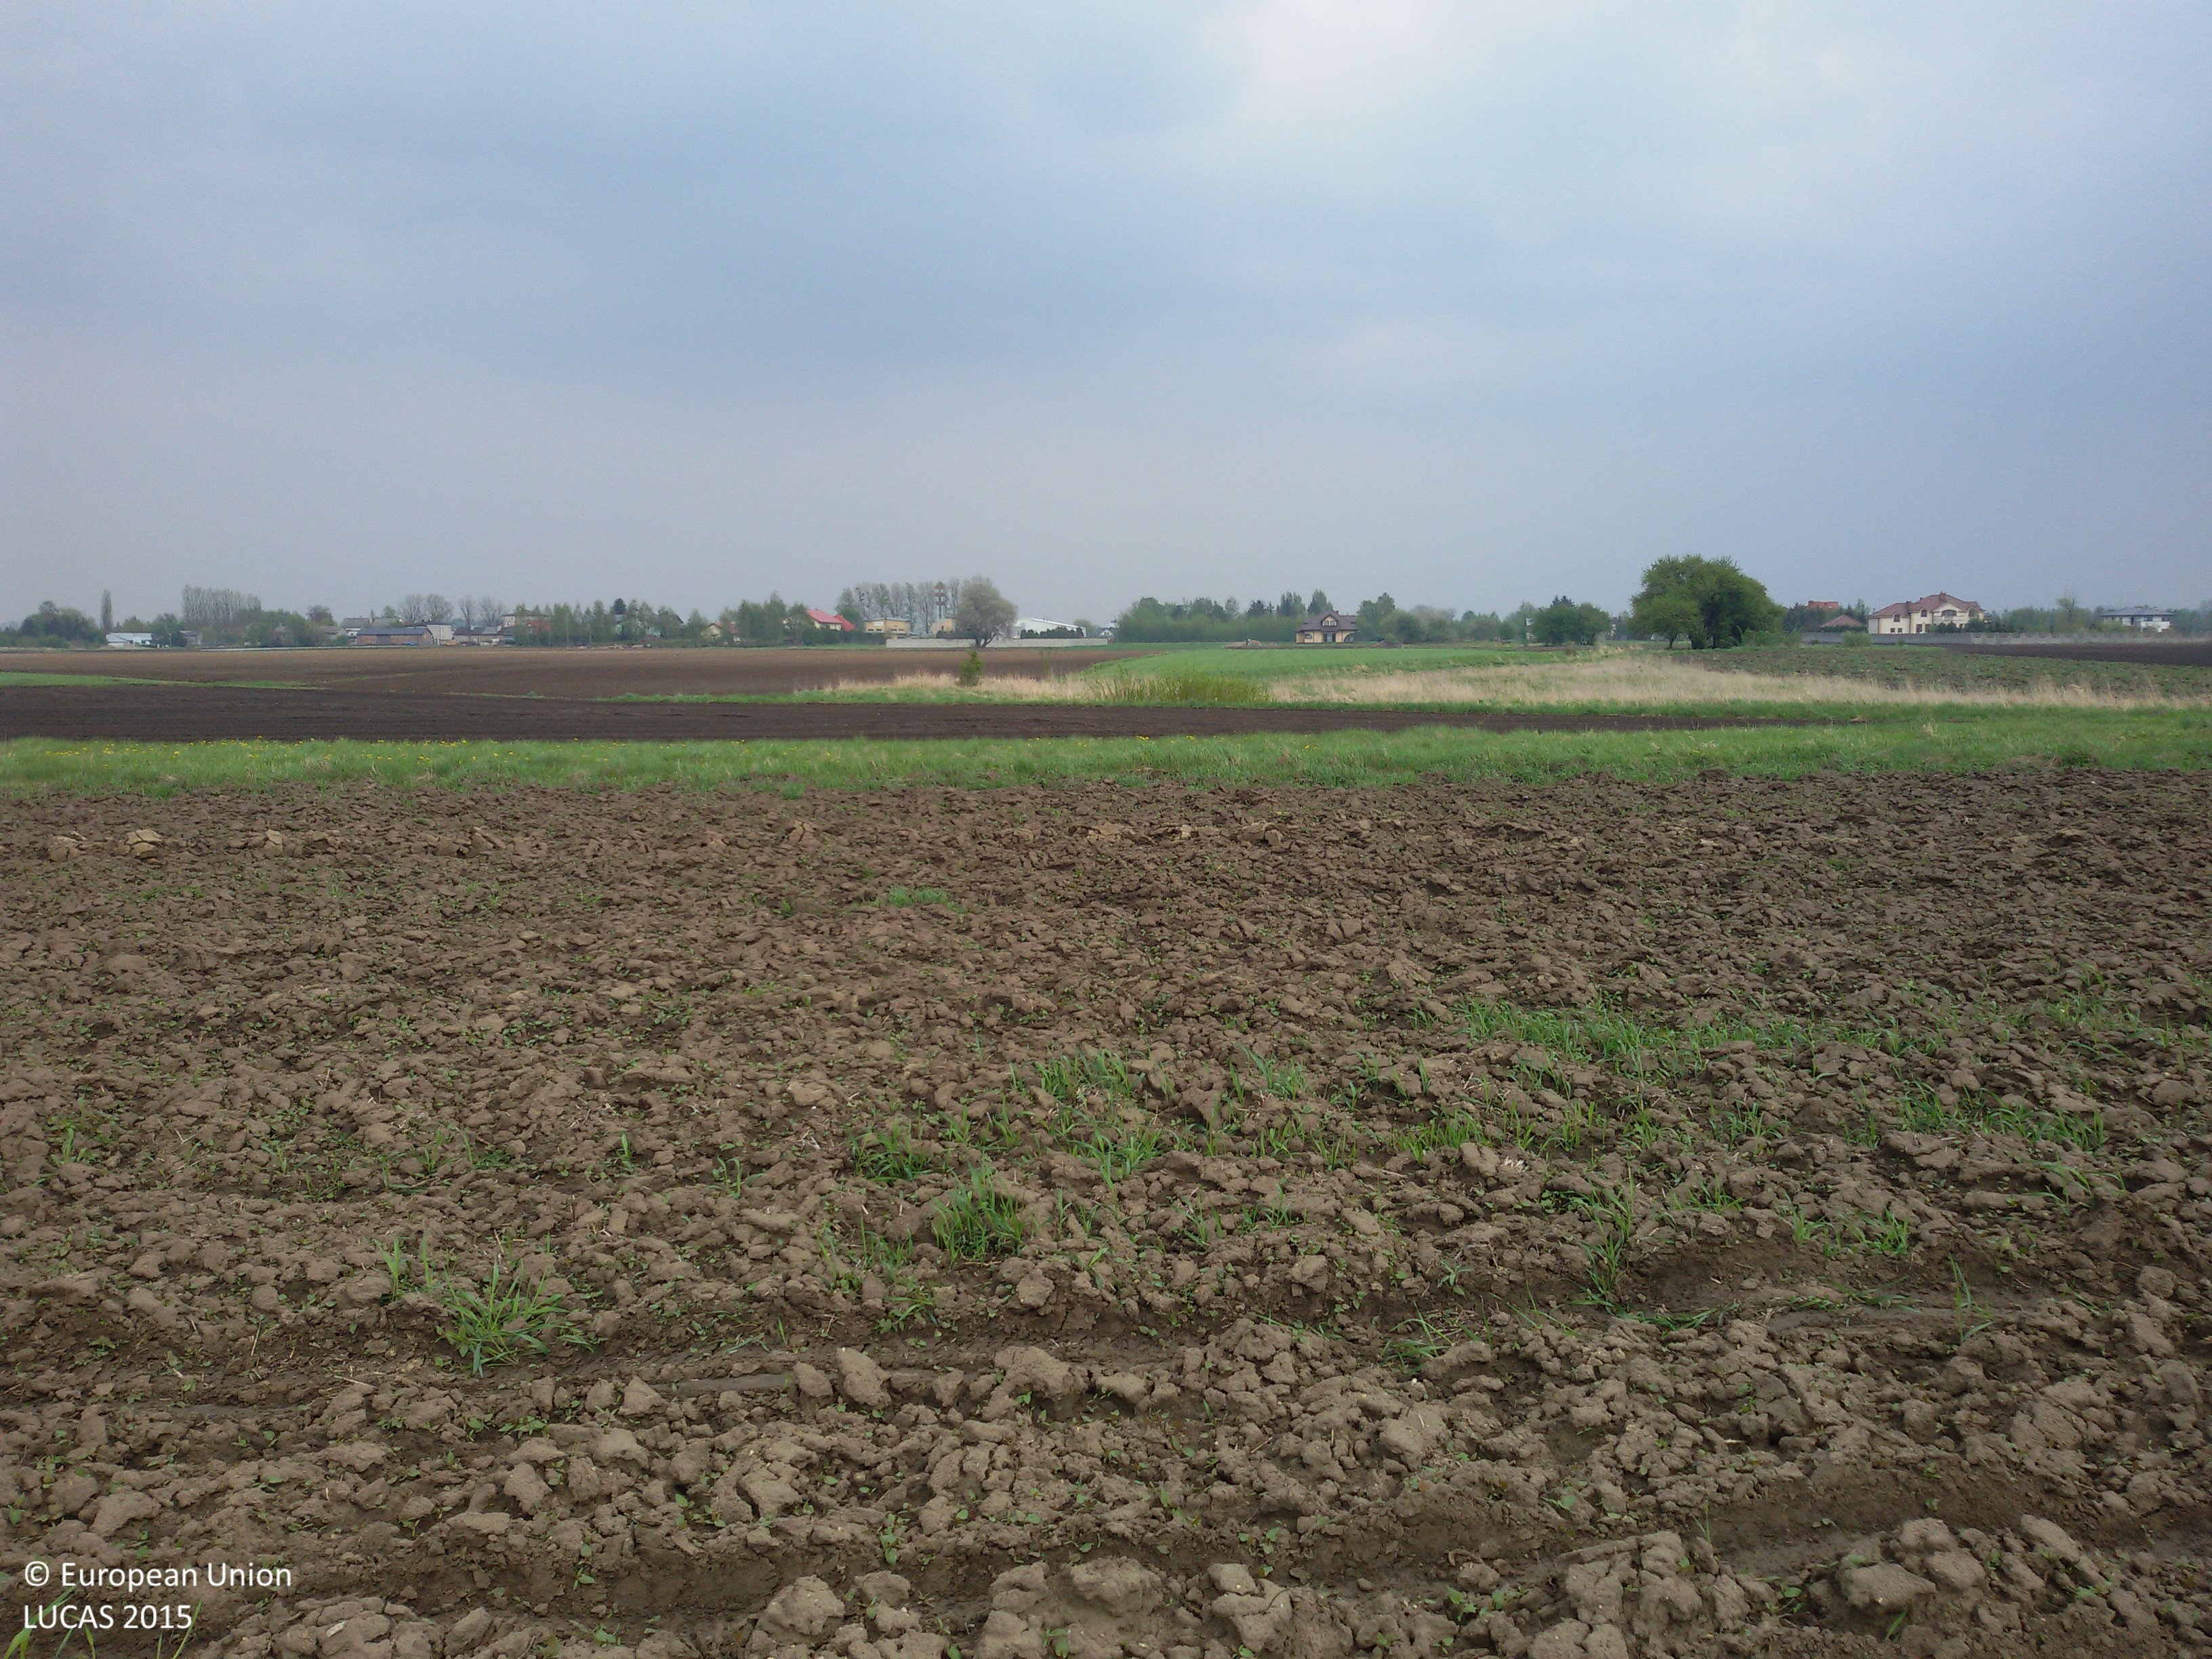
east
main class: Cropland
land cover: Potatoes
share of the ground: < 10 %
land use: Agriculture (excluding fallow land and kitchen gardens)
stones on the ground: < 10 %
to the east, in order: Potatoes; Other cereals; Grassland without tree/shrub cover; Maize; Grass margins; Ditches and canals; Grassland without tree/shrub cover; Ditches and canals; Grass margins; Maize
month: May
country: PL
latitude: 52.2481
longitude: 20.7778
